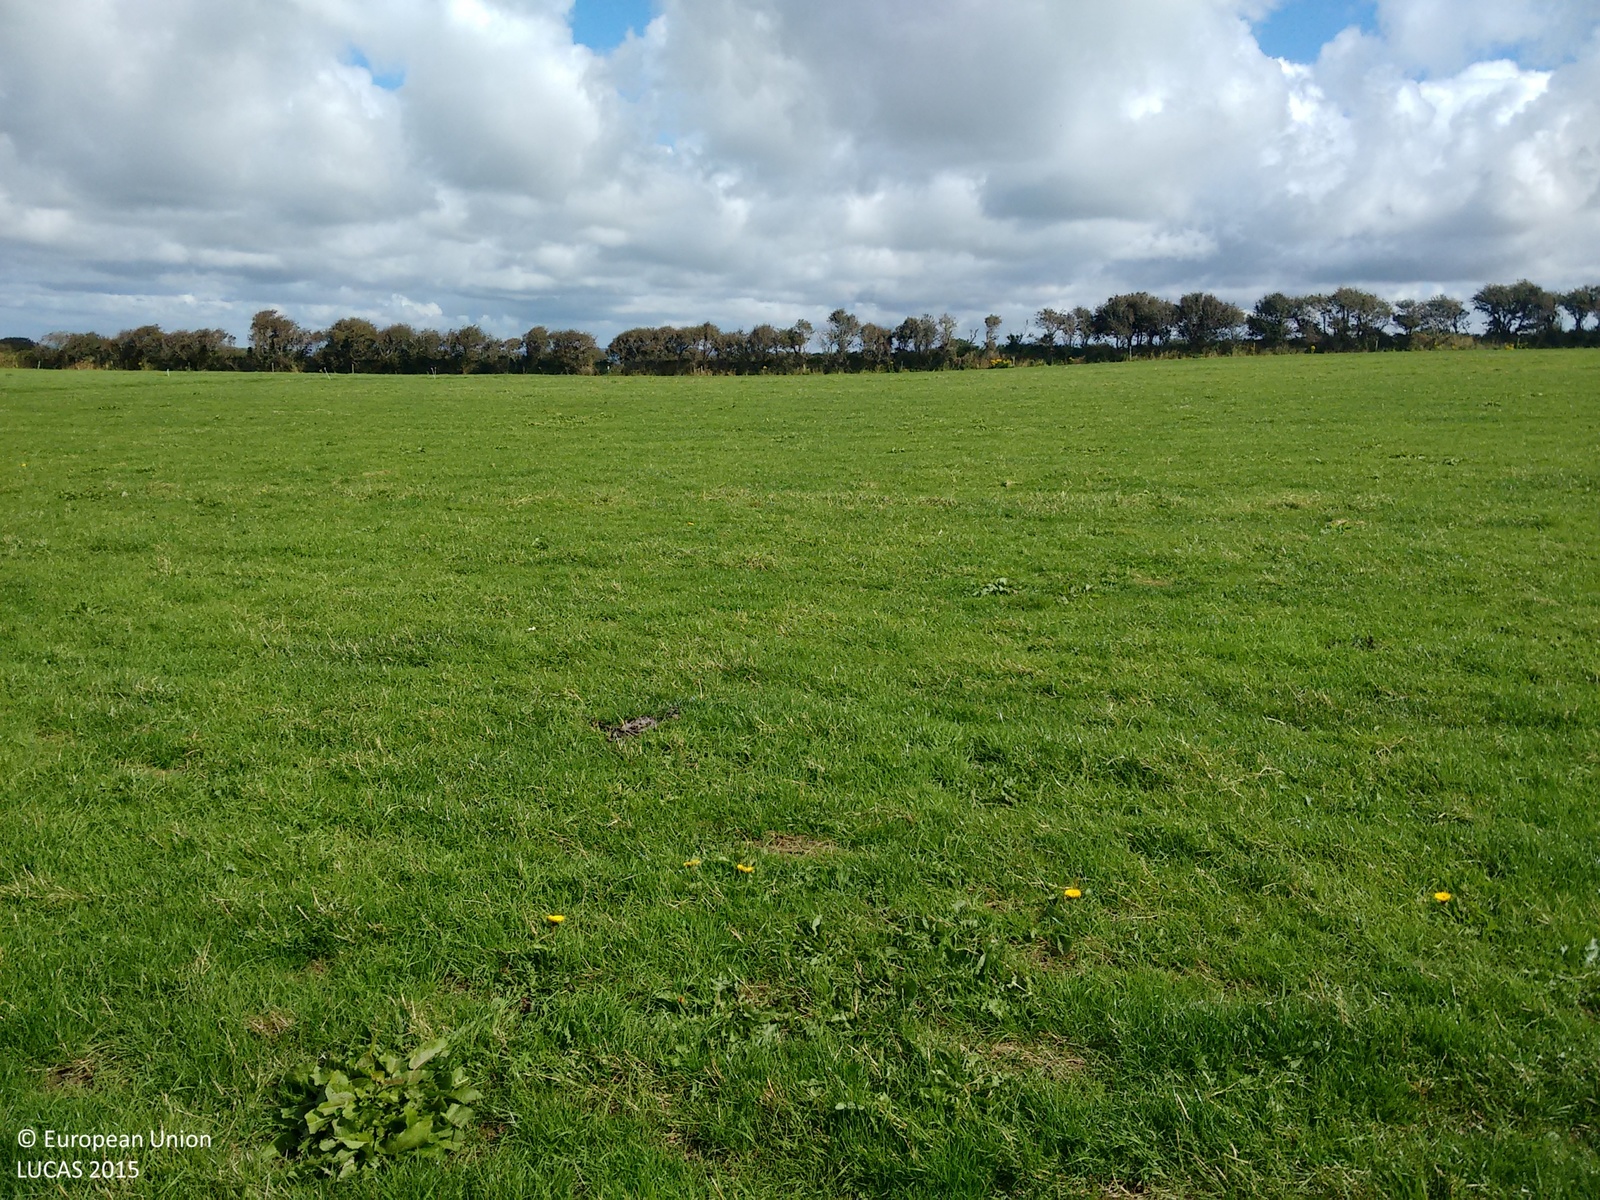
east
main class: Grassland
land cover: Grassland without tree/shrub cover
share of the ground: > 75 %
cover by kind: herbaceous plants 90 %, shrubs 5 %, unconsolidated bare surface 5 %
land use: Agriculture (excluding fallow land and kitchen gardens)
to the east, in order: Grassland without tree/shrub cover; Fences; Abandoned hedges; Grassland without tree/shrub cover; Fences; Abandoned hedges; Grassland without tree/shrub cover
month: September
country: IE
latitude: 52.3606
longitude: -9.7593
